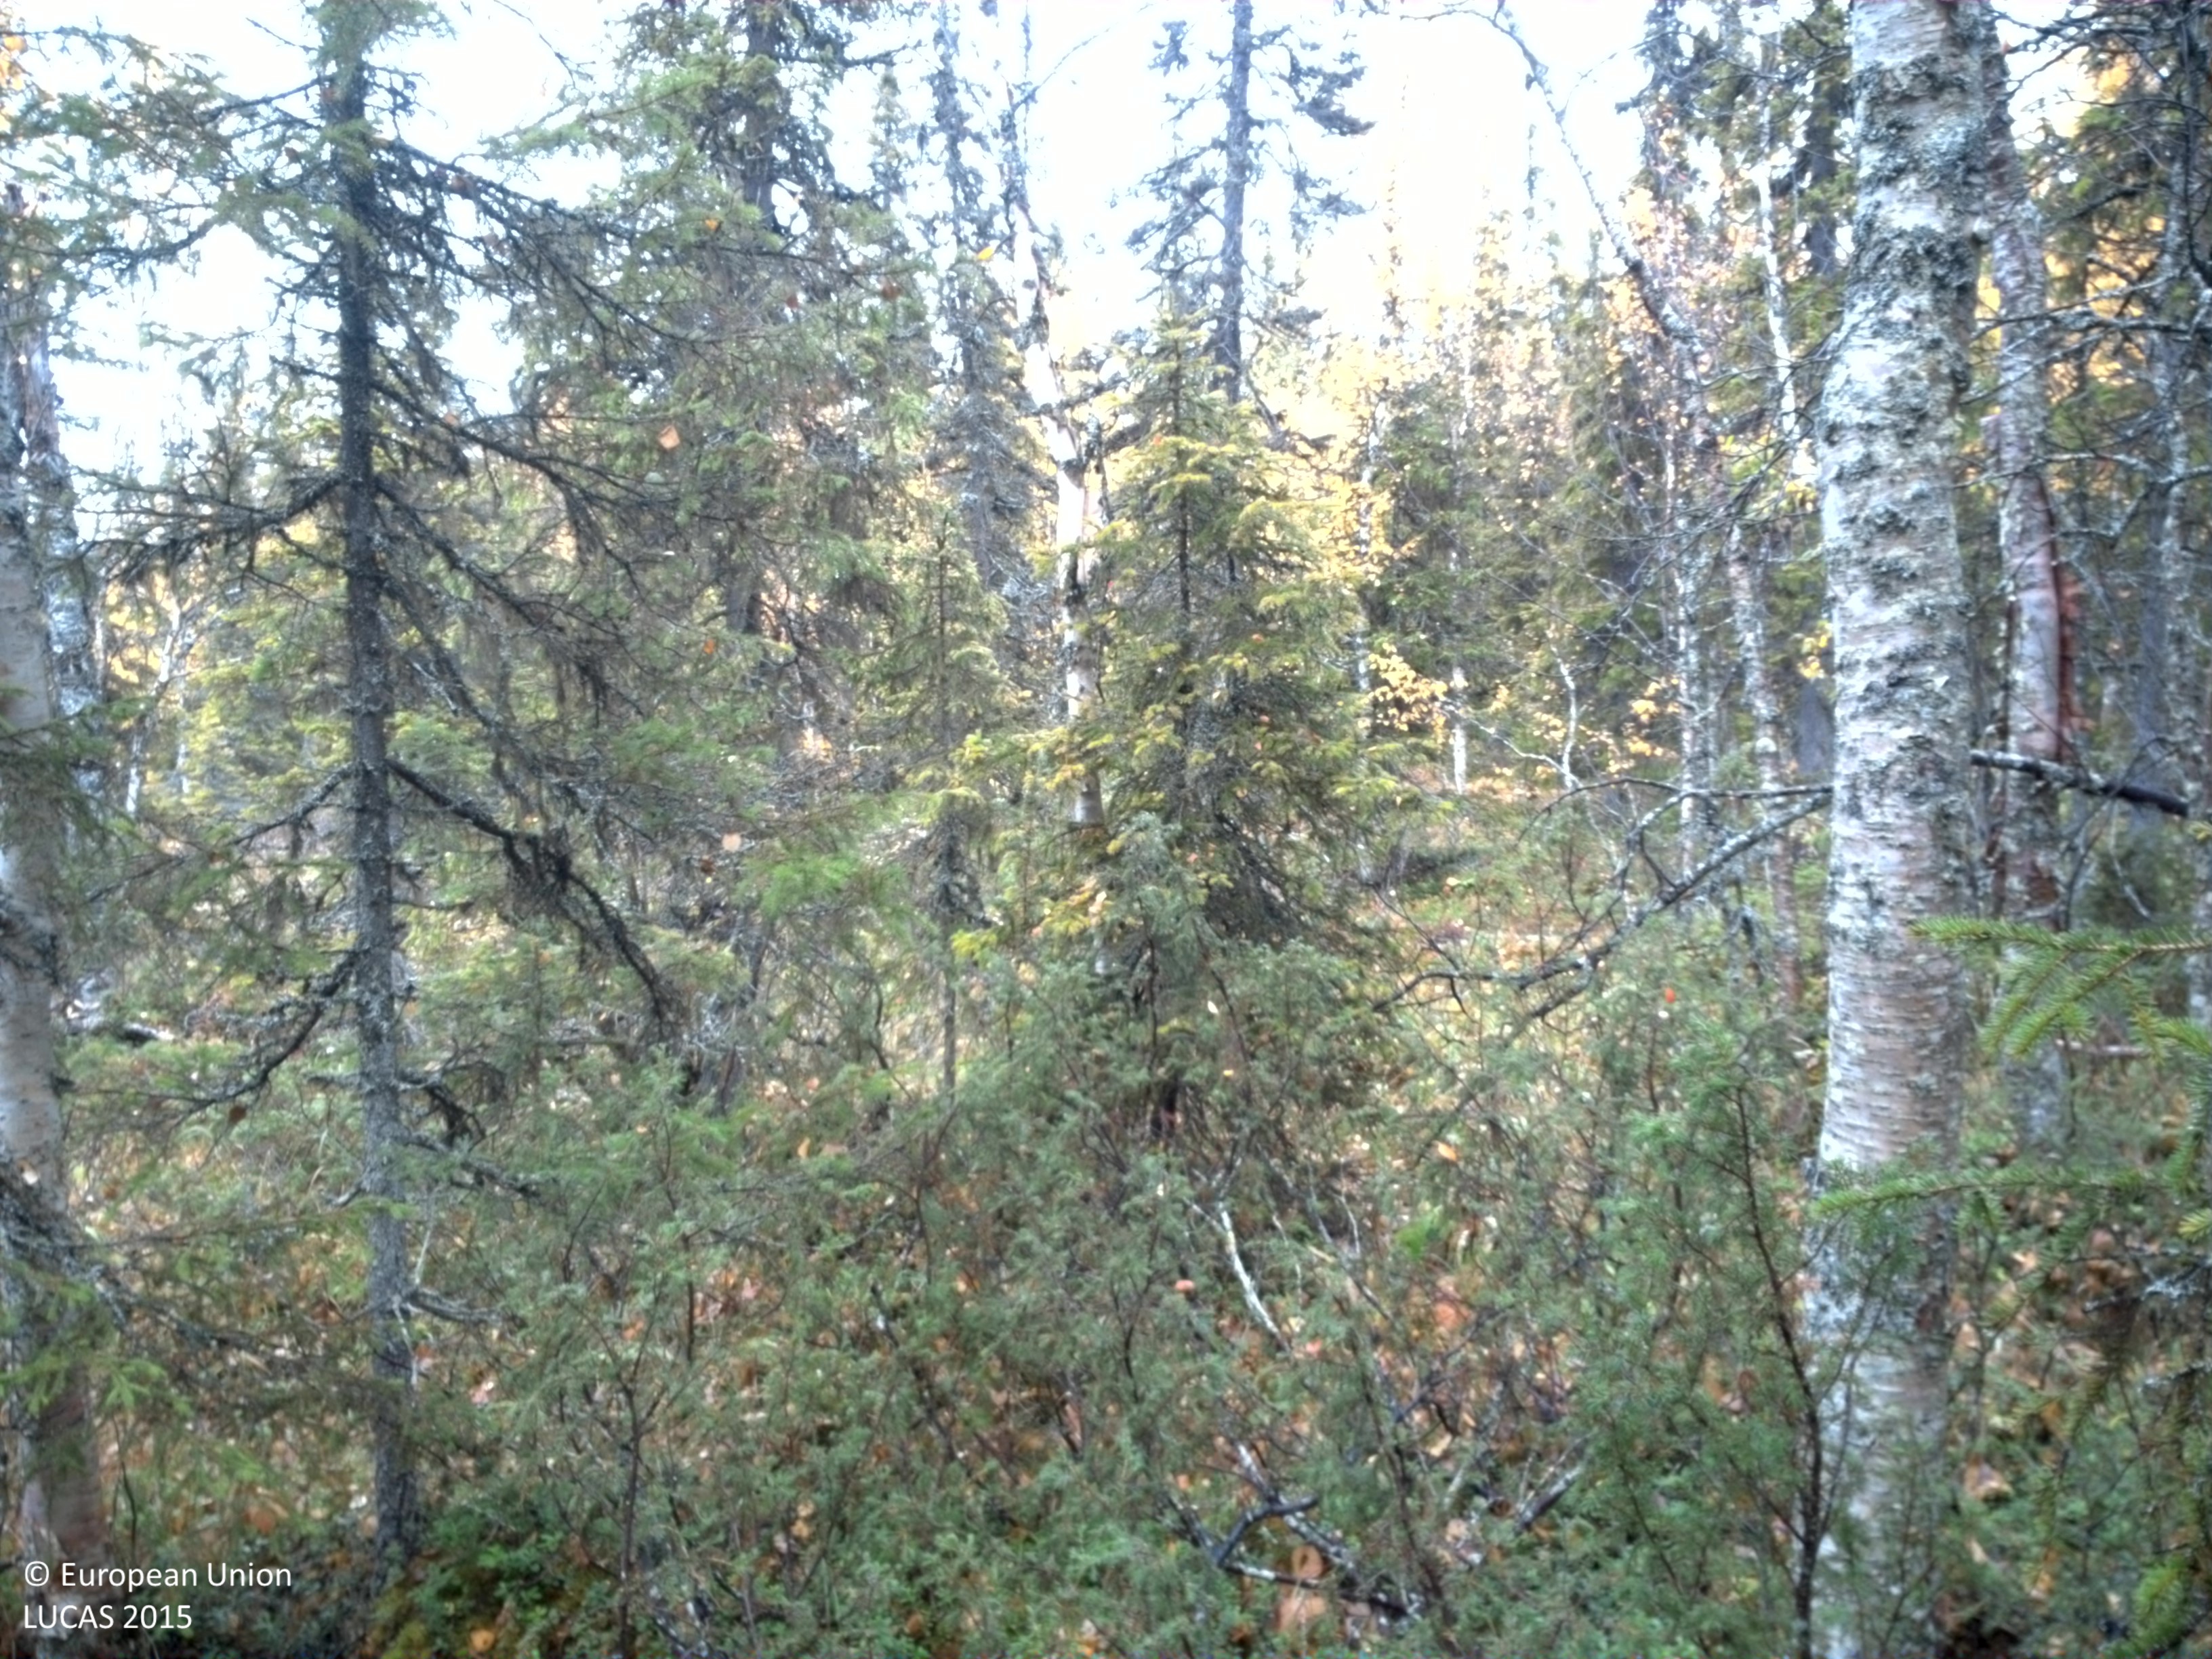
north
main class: Woodland
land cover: Spruce dominated mixed woodland
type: boreal forest
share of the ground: 50 - 75 %
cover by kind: coniferous forest trees 35 %, shrubs 35 %, broadleaved forest trees 15 %, lichens and mosses 10 %, herbaceous plants 5 %
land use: Forestry
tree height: > 5 m
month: September
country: SE
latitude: 65.0777
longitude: 16.5785
